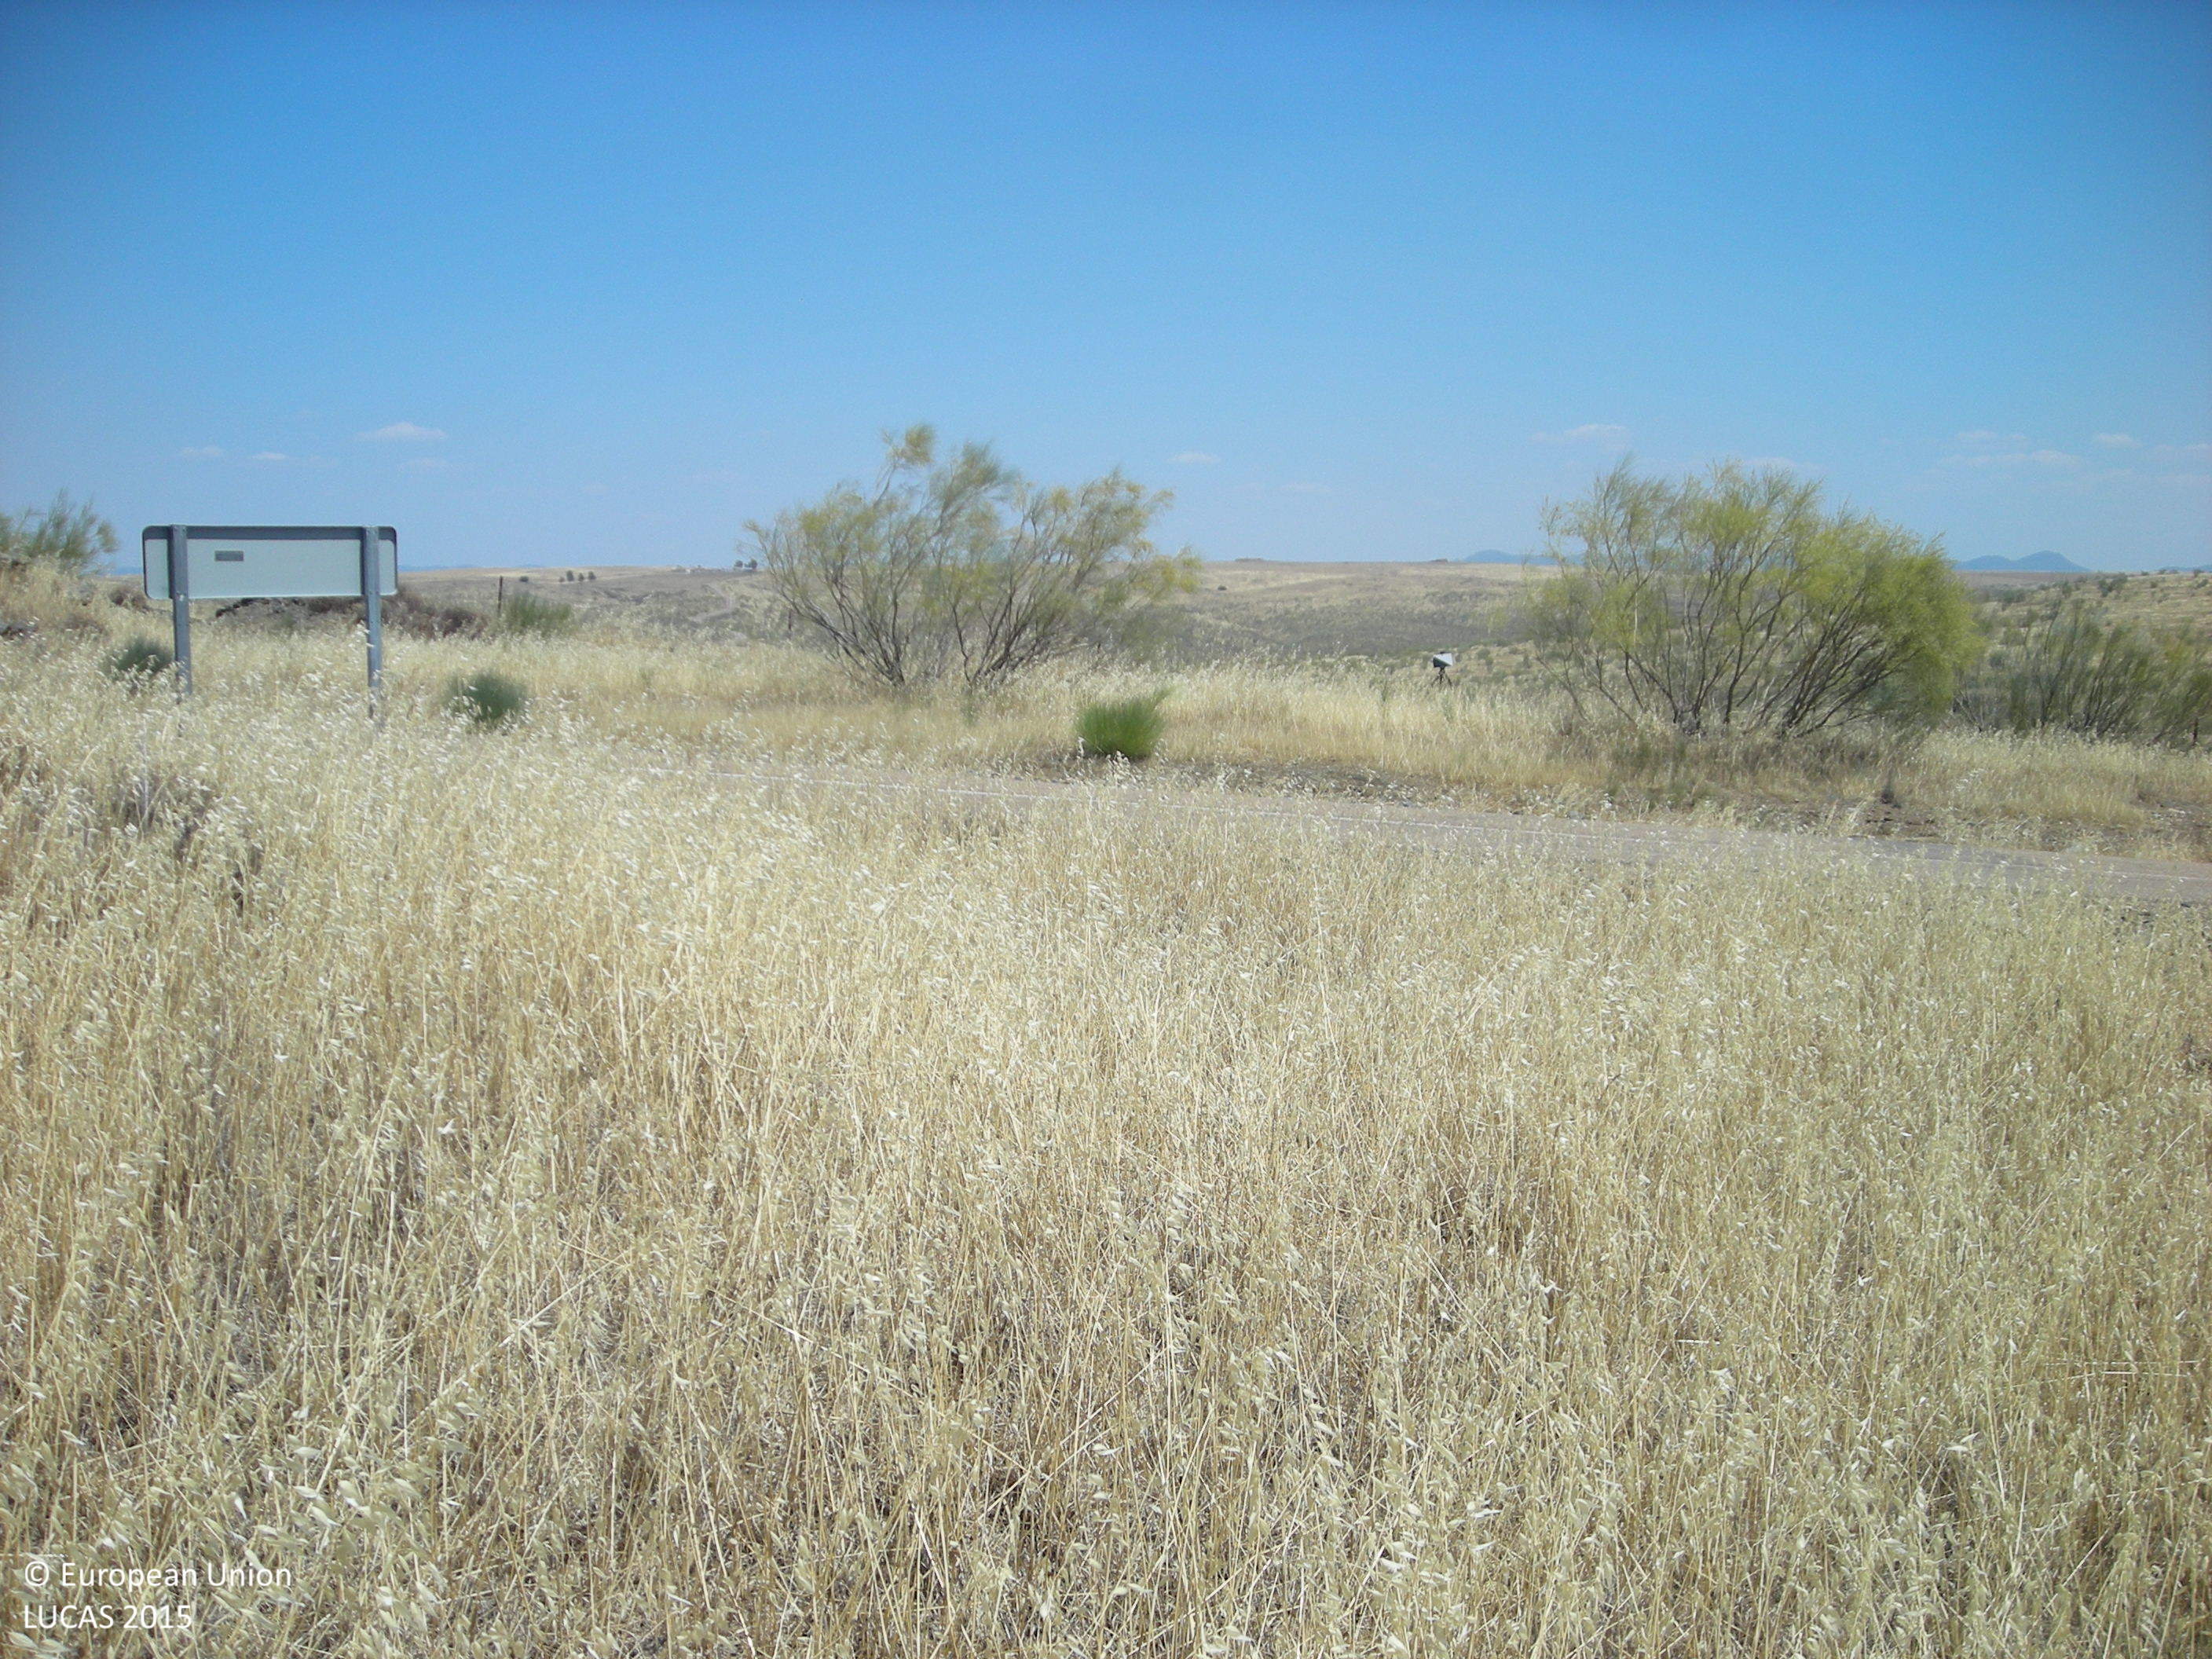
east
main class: Grassland
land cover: Grassland without tree/shrub cover
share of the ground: > 75 %
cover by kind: herbaceous plants 100 %
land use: Agriculture (excluding fallow land and kitchen gardens)
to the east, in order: Grassland without tree/shrub cover; Rivers and streams; Grassland without tree/shrub cover; Rock outcrops
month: June
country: ES
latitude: 38.8696
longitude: -5.4505
